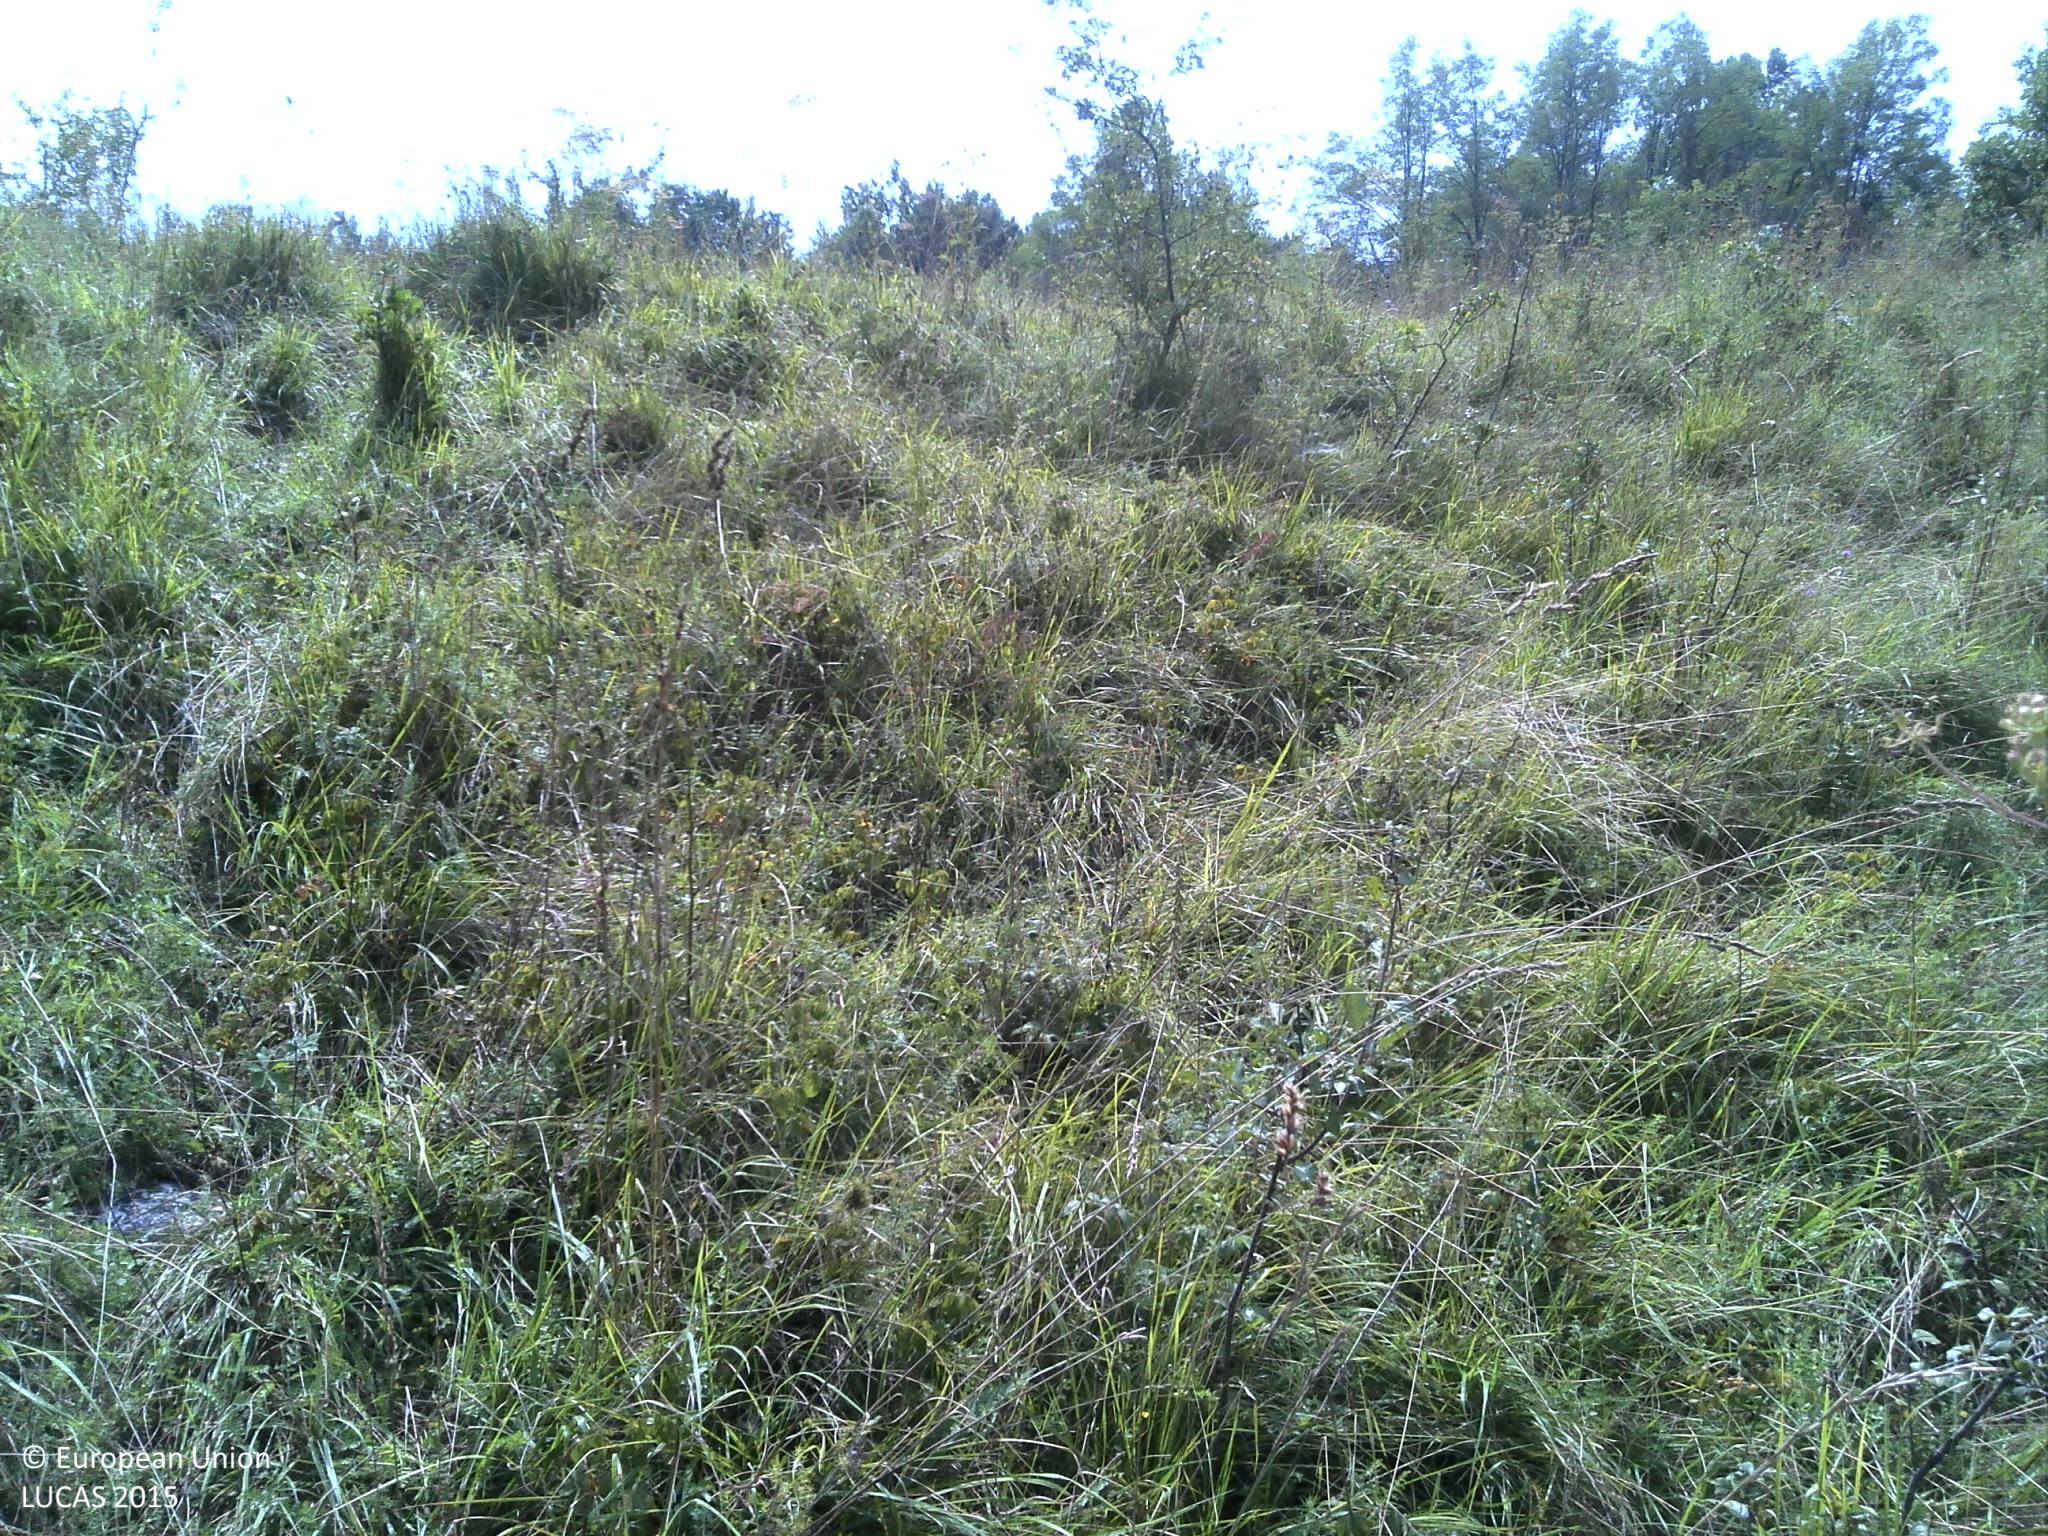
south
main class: Cropland
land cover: Lucerne
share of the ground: > 75 %
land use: Agriculture (excluding fallow land and kitchen gardens)
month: September
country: HR
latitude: 45.4460
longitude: 15.2506
